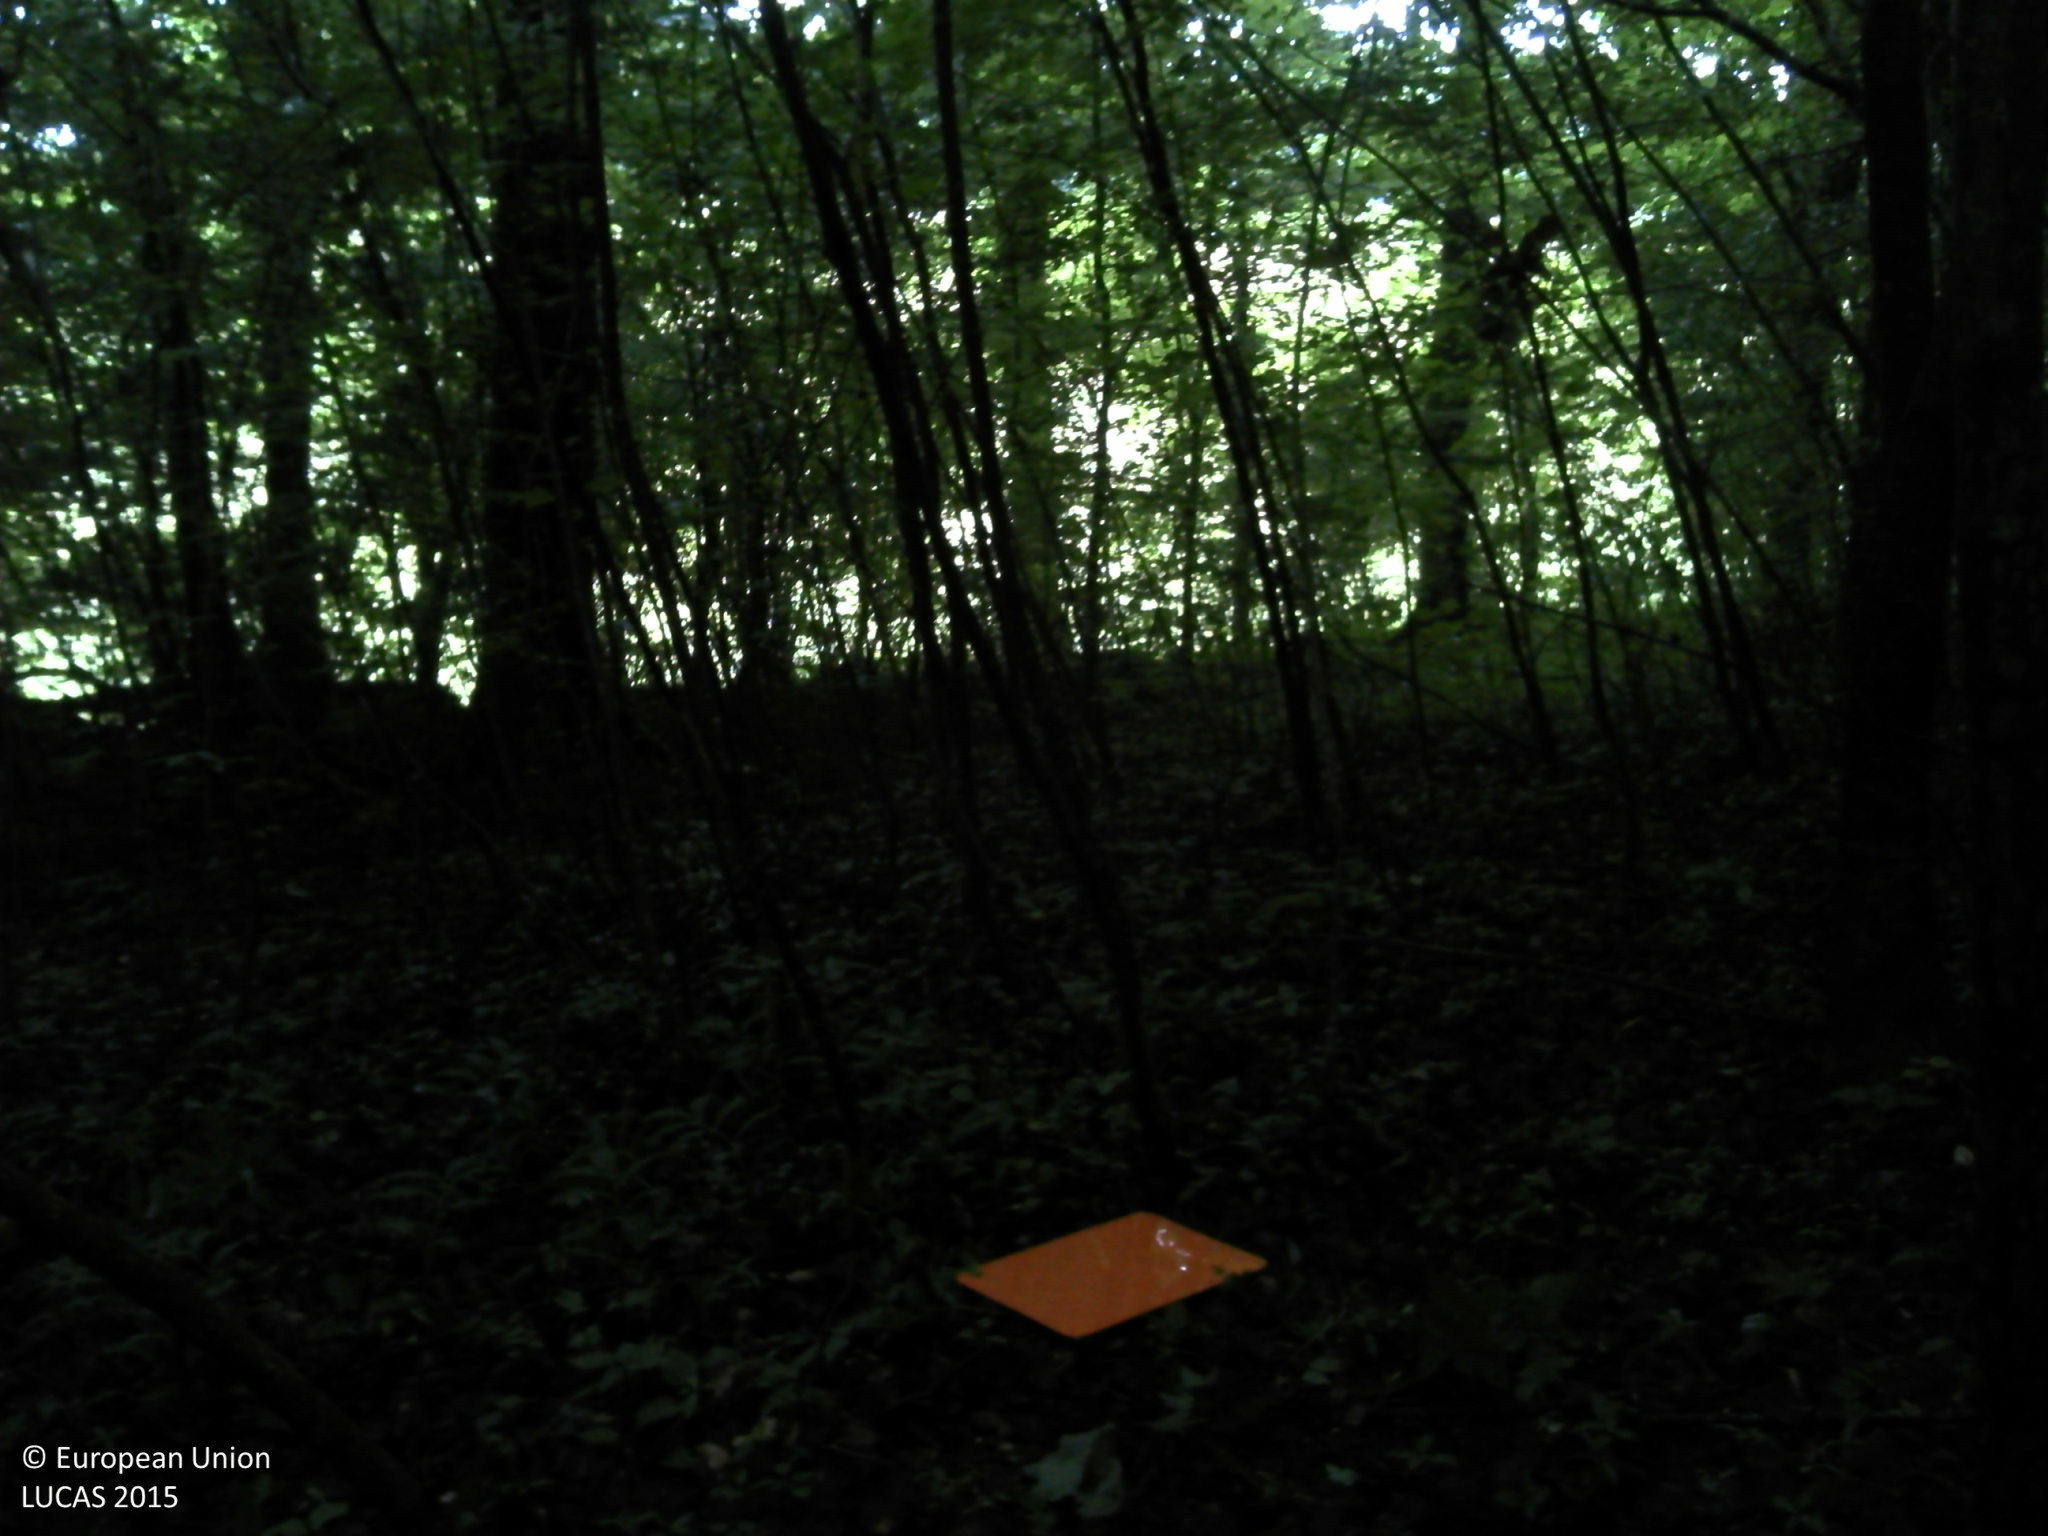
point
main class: Woodland
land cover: Broadleaved woodland
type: beech forest
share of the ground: > 75 %
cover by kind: broadleaved forest trees 75 %, herbaceous plants 15 %, consolidated bare surface 10 %
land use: Forestry
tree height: > 5 m
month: June
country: FR
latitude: 49.6679
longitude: 4.7733
